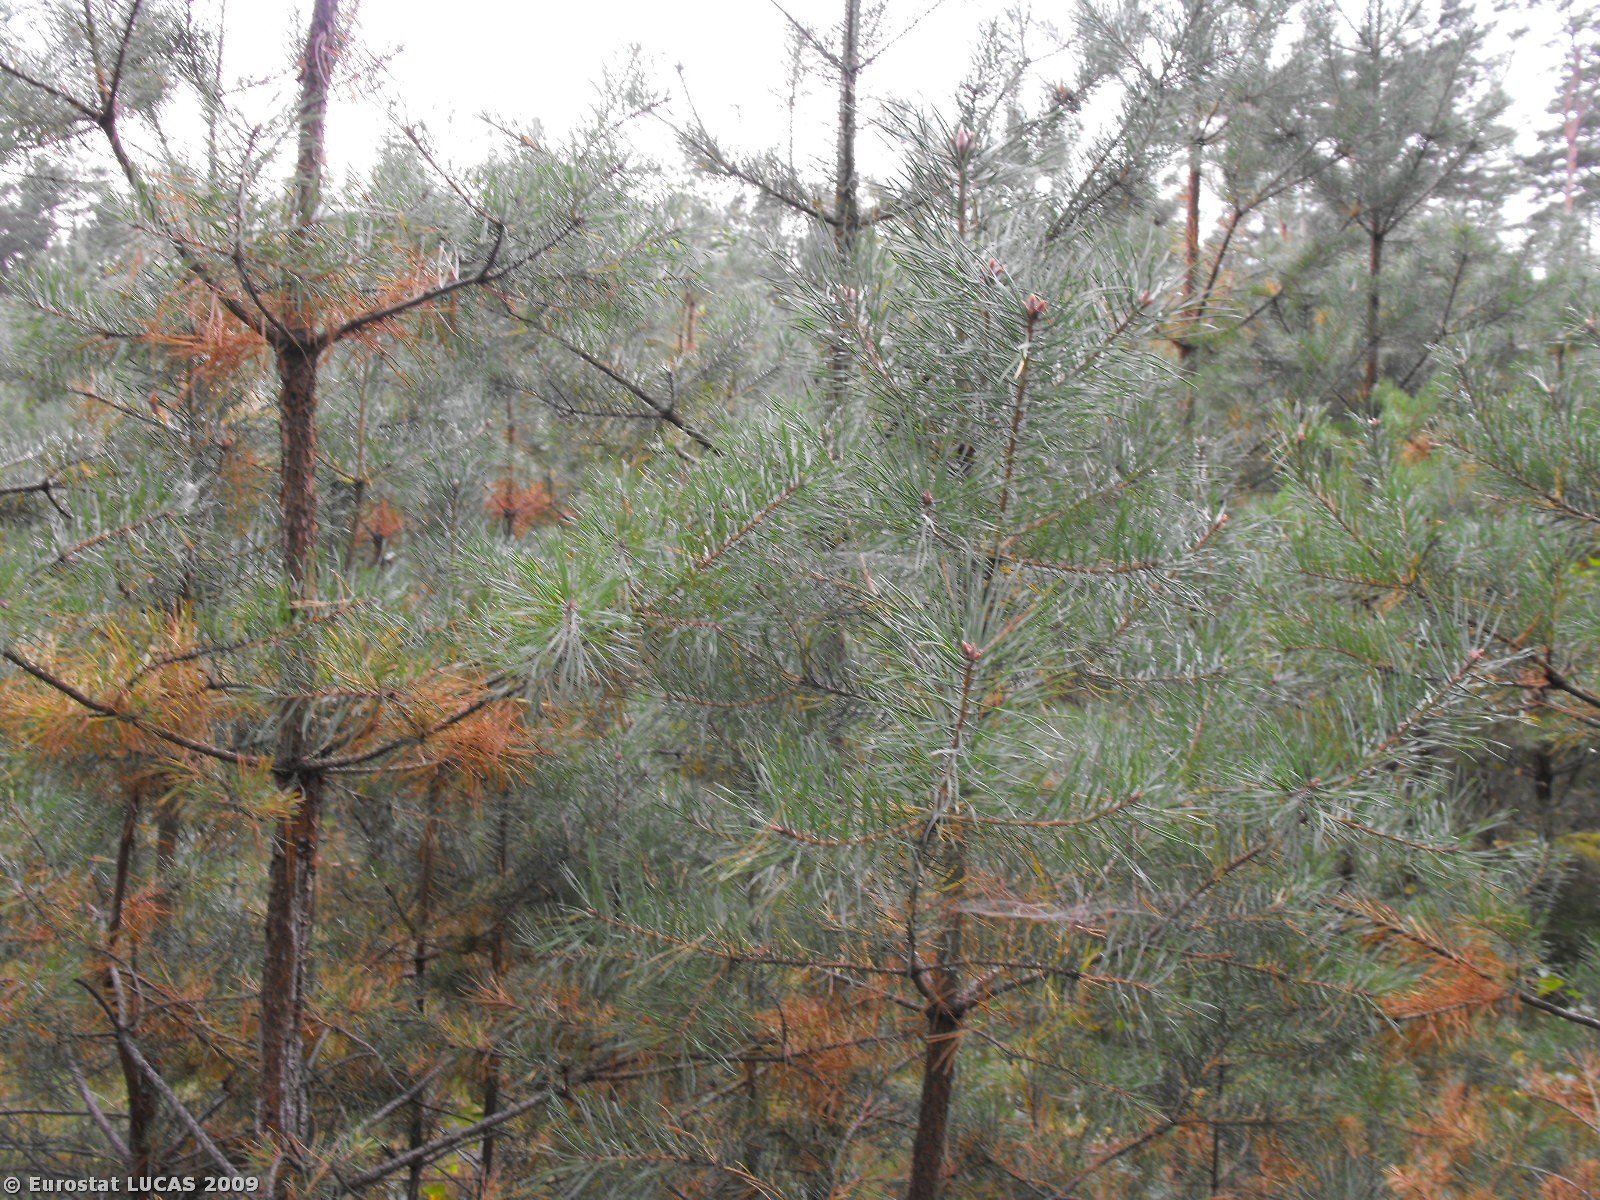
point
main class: Woodland
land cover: Coniferous woodland
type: hemiboreal forest and nemoral coniferous forest and mixed broadleaved-coniferous forest
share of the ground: > 75 %
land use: Forestry
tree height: > 5 m
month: September
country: PL
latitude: 53.0046
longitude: 16.2801
